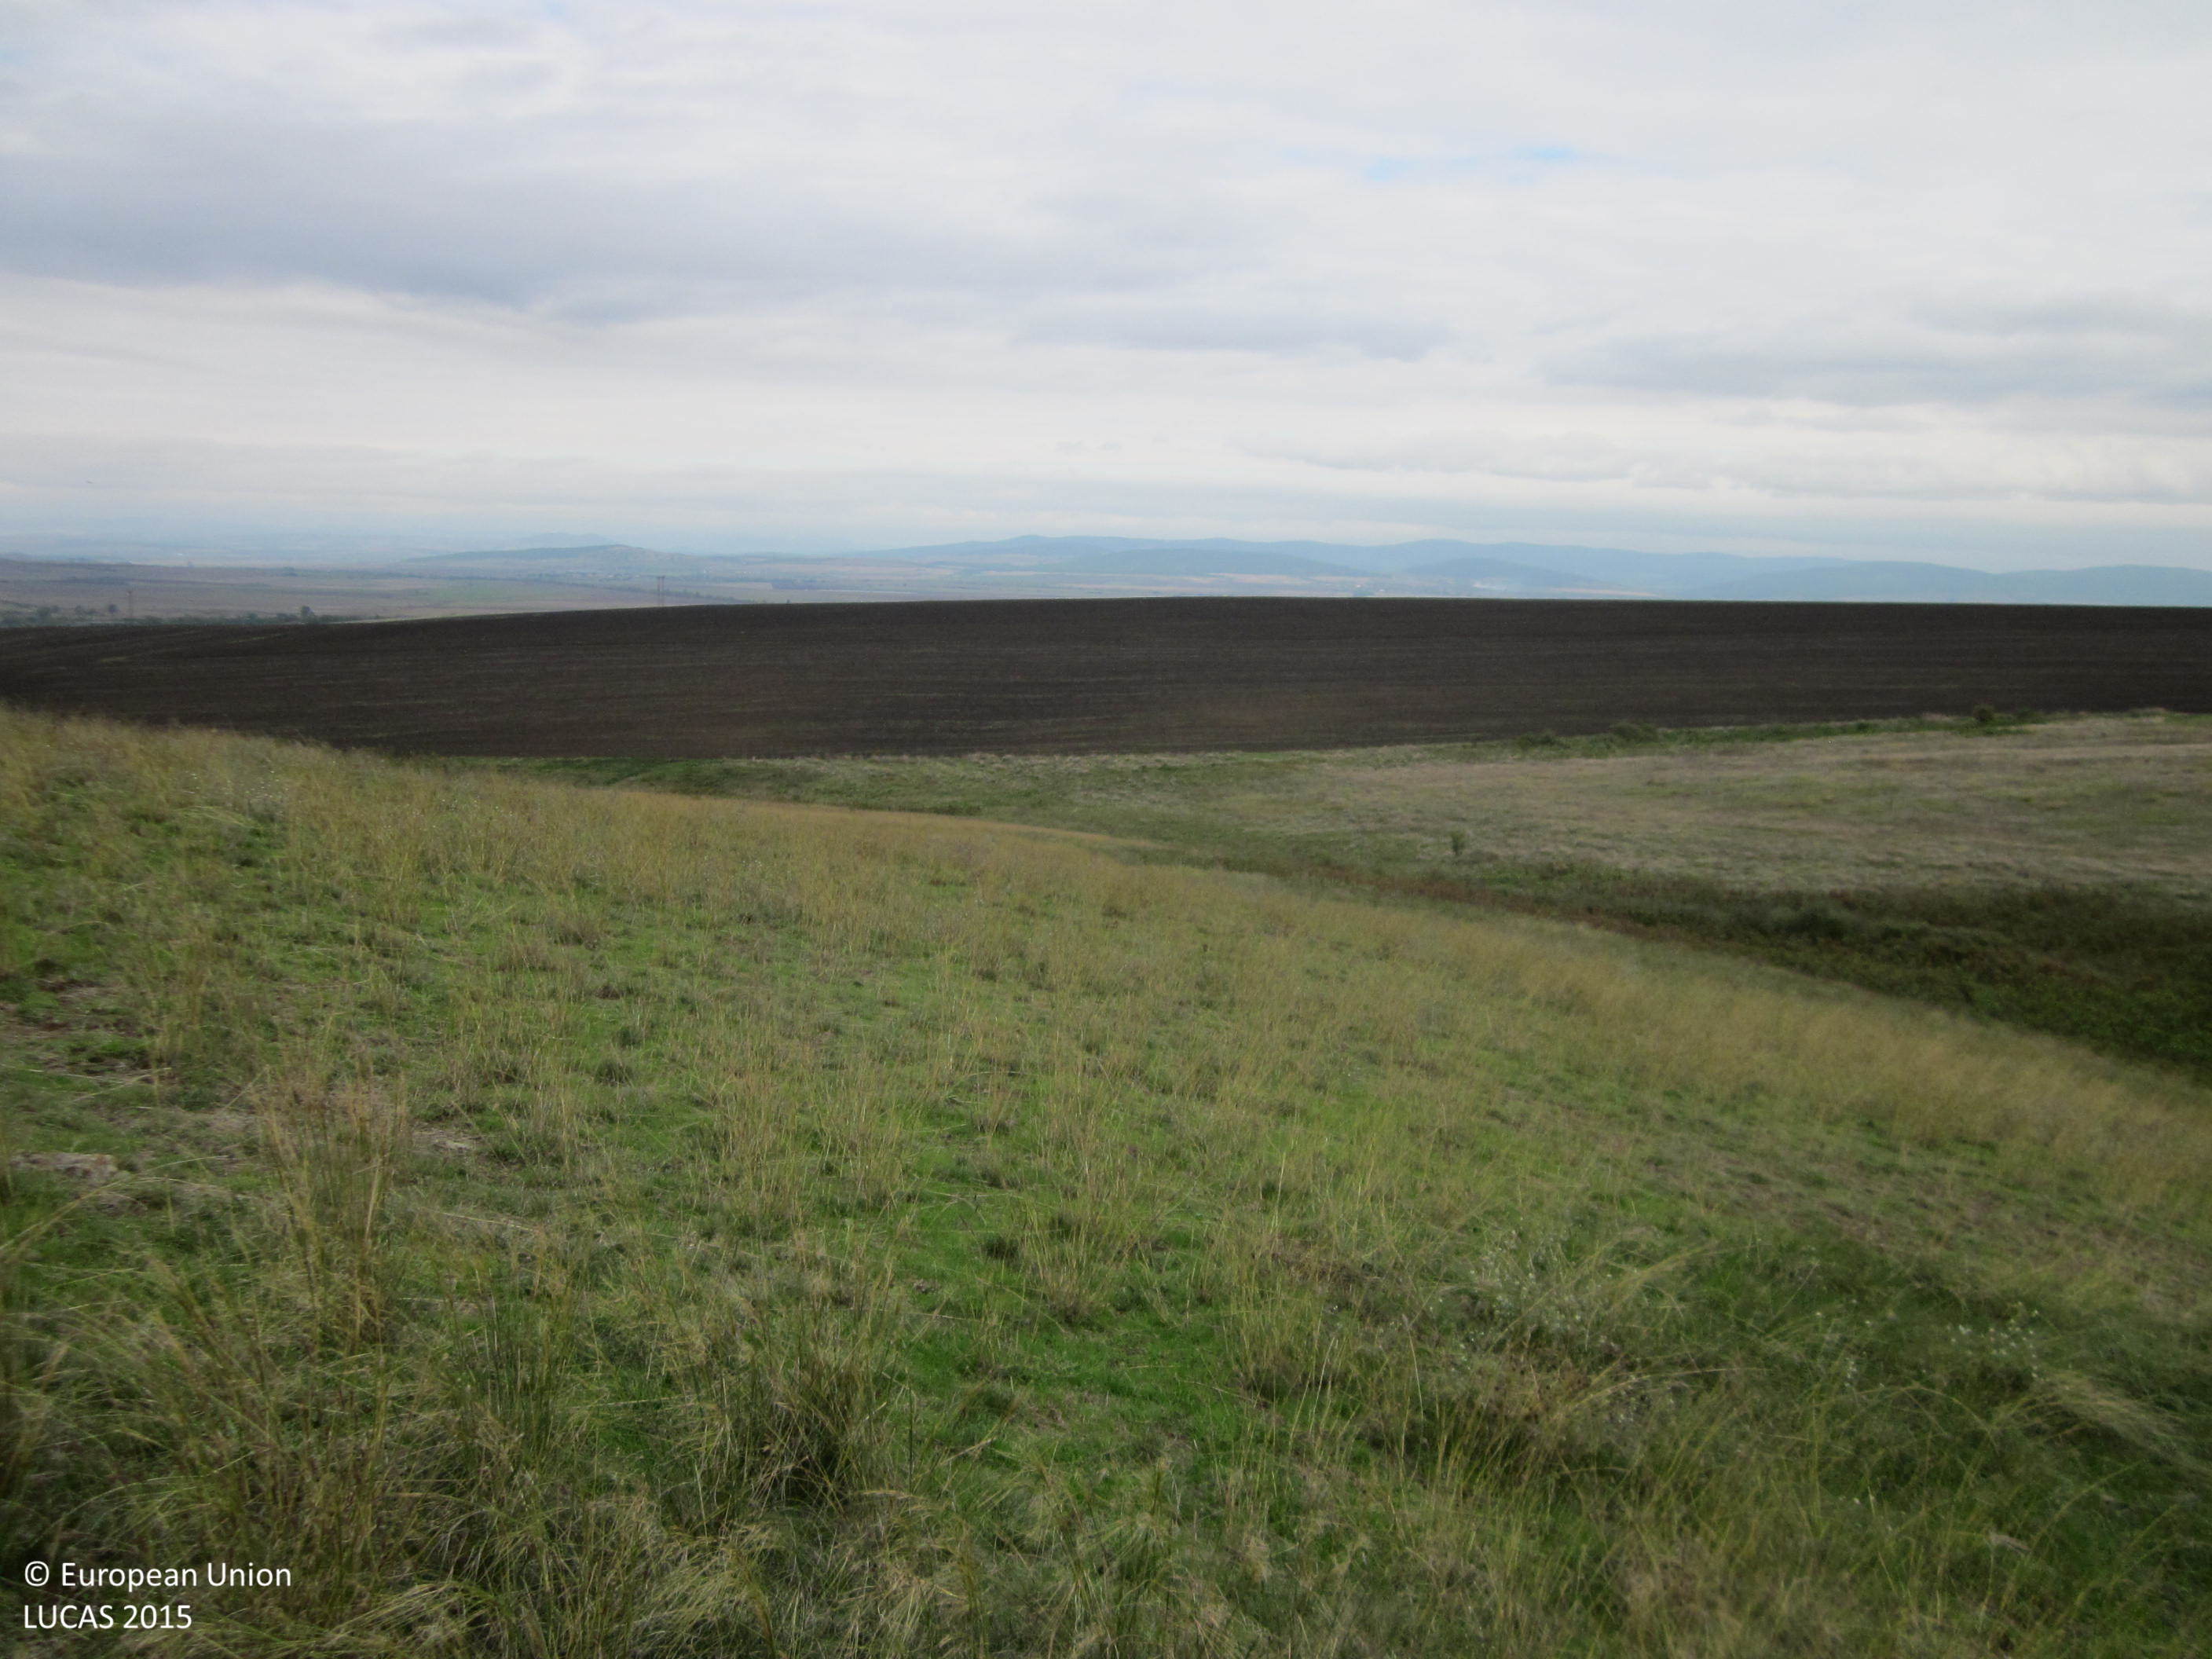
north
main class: Grassland
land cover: Grassland without tree/shrub cover
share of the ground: > 75 %
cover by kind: herbaceous plants 100 %
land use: Agriculture (excluding fallow land and kitchen gardens)
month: October
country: BG
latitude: 42.6357
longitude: 26.9212
